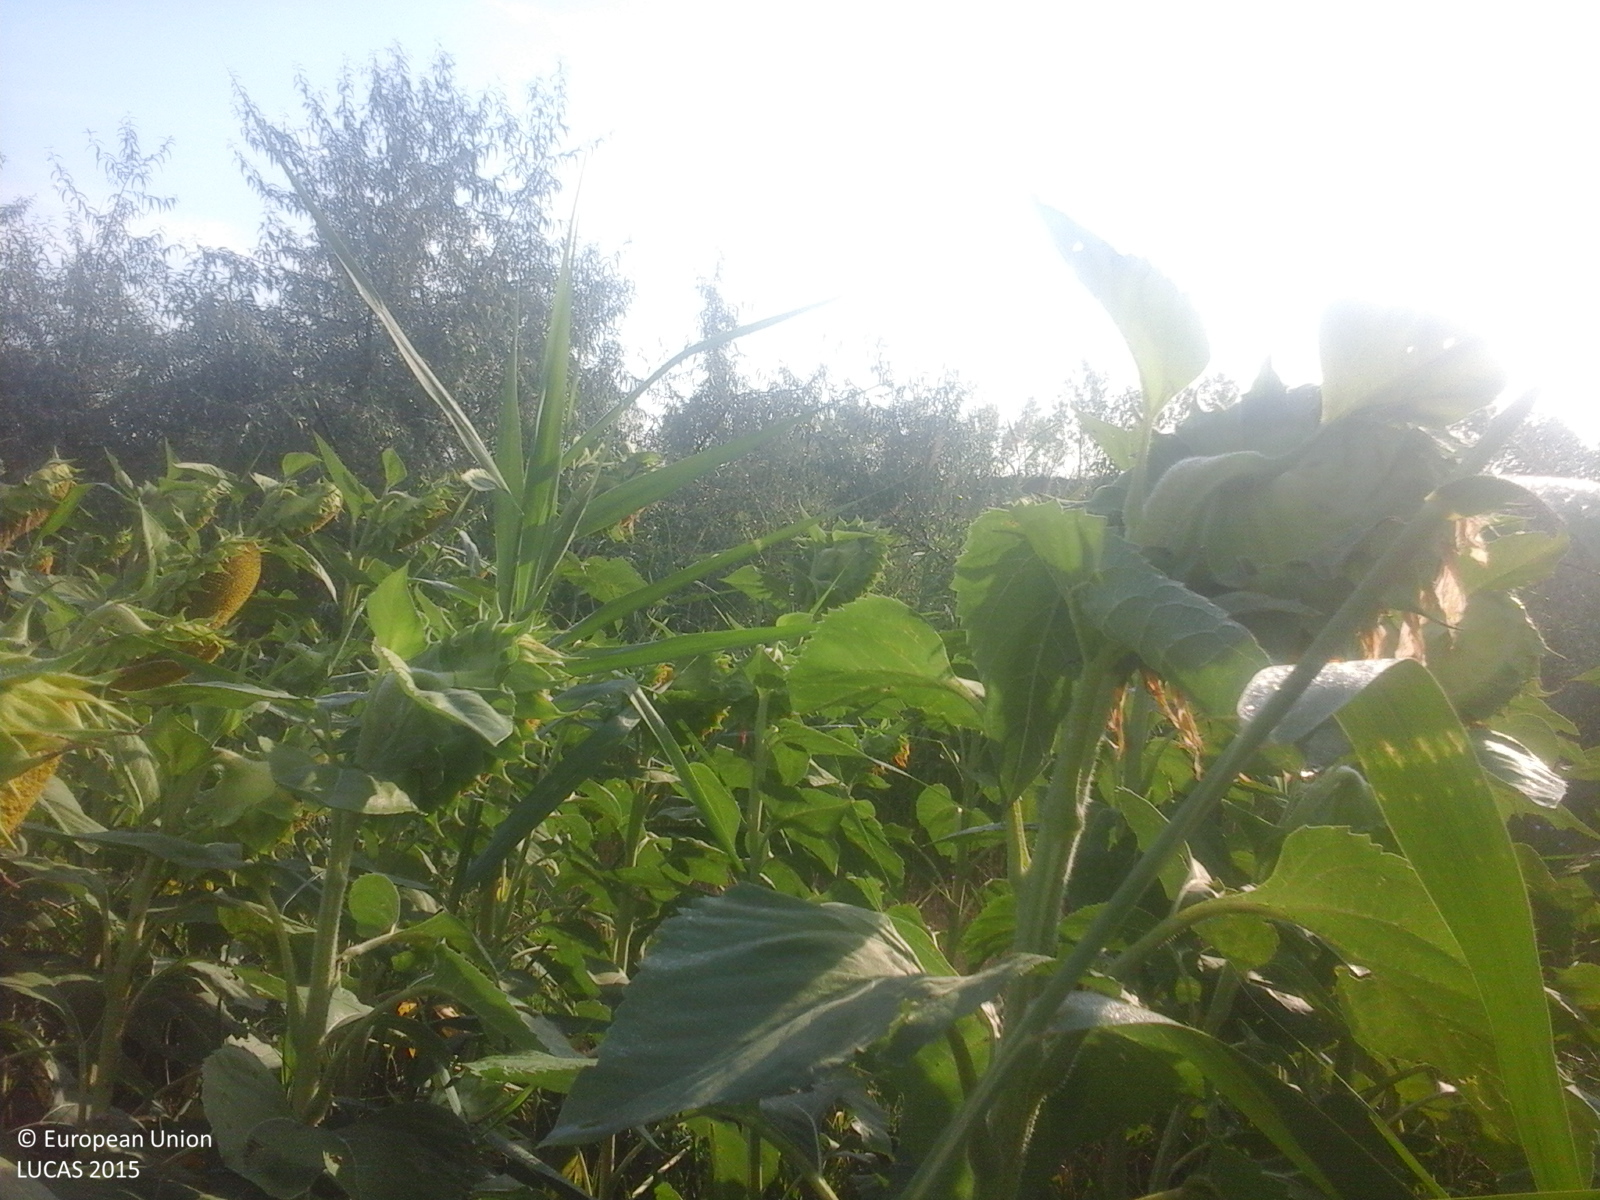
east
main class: Cropland
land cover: Sunflower
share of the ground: > 75 %
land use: Agriculture (excluding fallow land and kitchen gardens)
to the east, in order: Sunflower; Tracks; Abandoned hedges; Ditches and canals; Shruby margins; Maize; Electric lines; Maize; Ditches and canals; Tracks; Grassland without tree/shrub cover; Tracks; Grassland without tree/shrub cover; Tracks; Lines of trees; Grassland without tree/shrub cover; Tracks; Grassland without tree/shrub cover
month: July
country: RO
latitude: 46.7096
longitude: 28.1989
